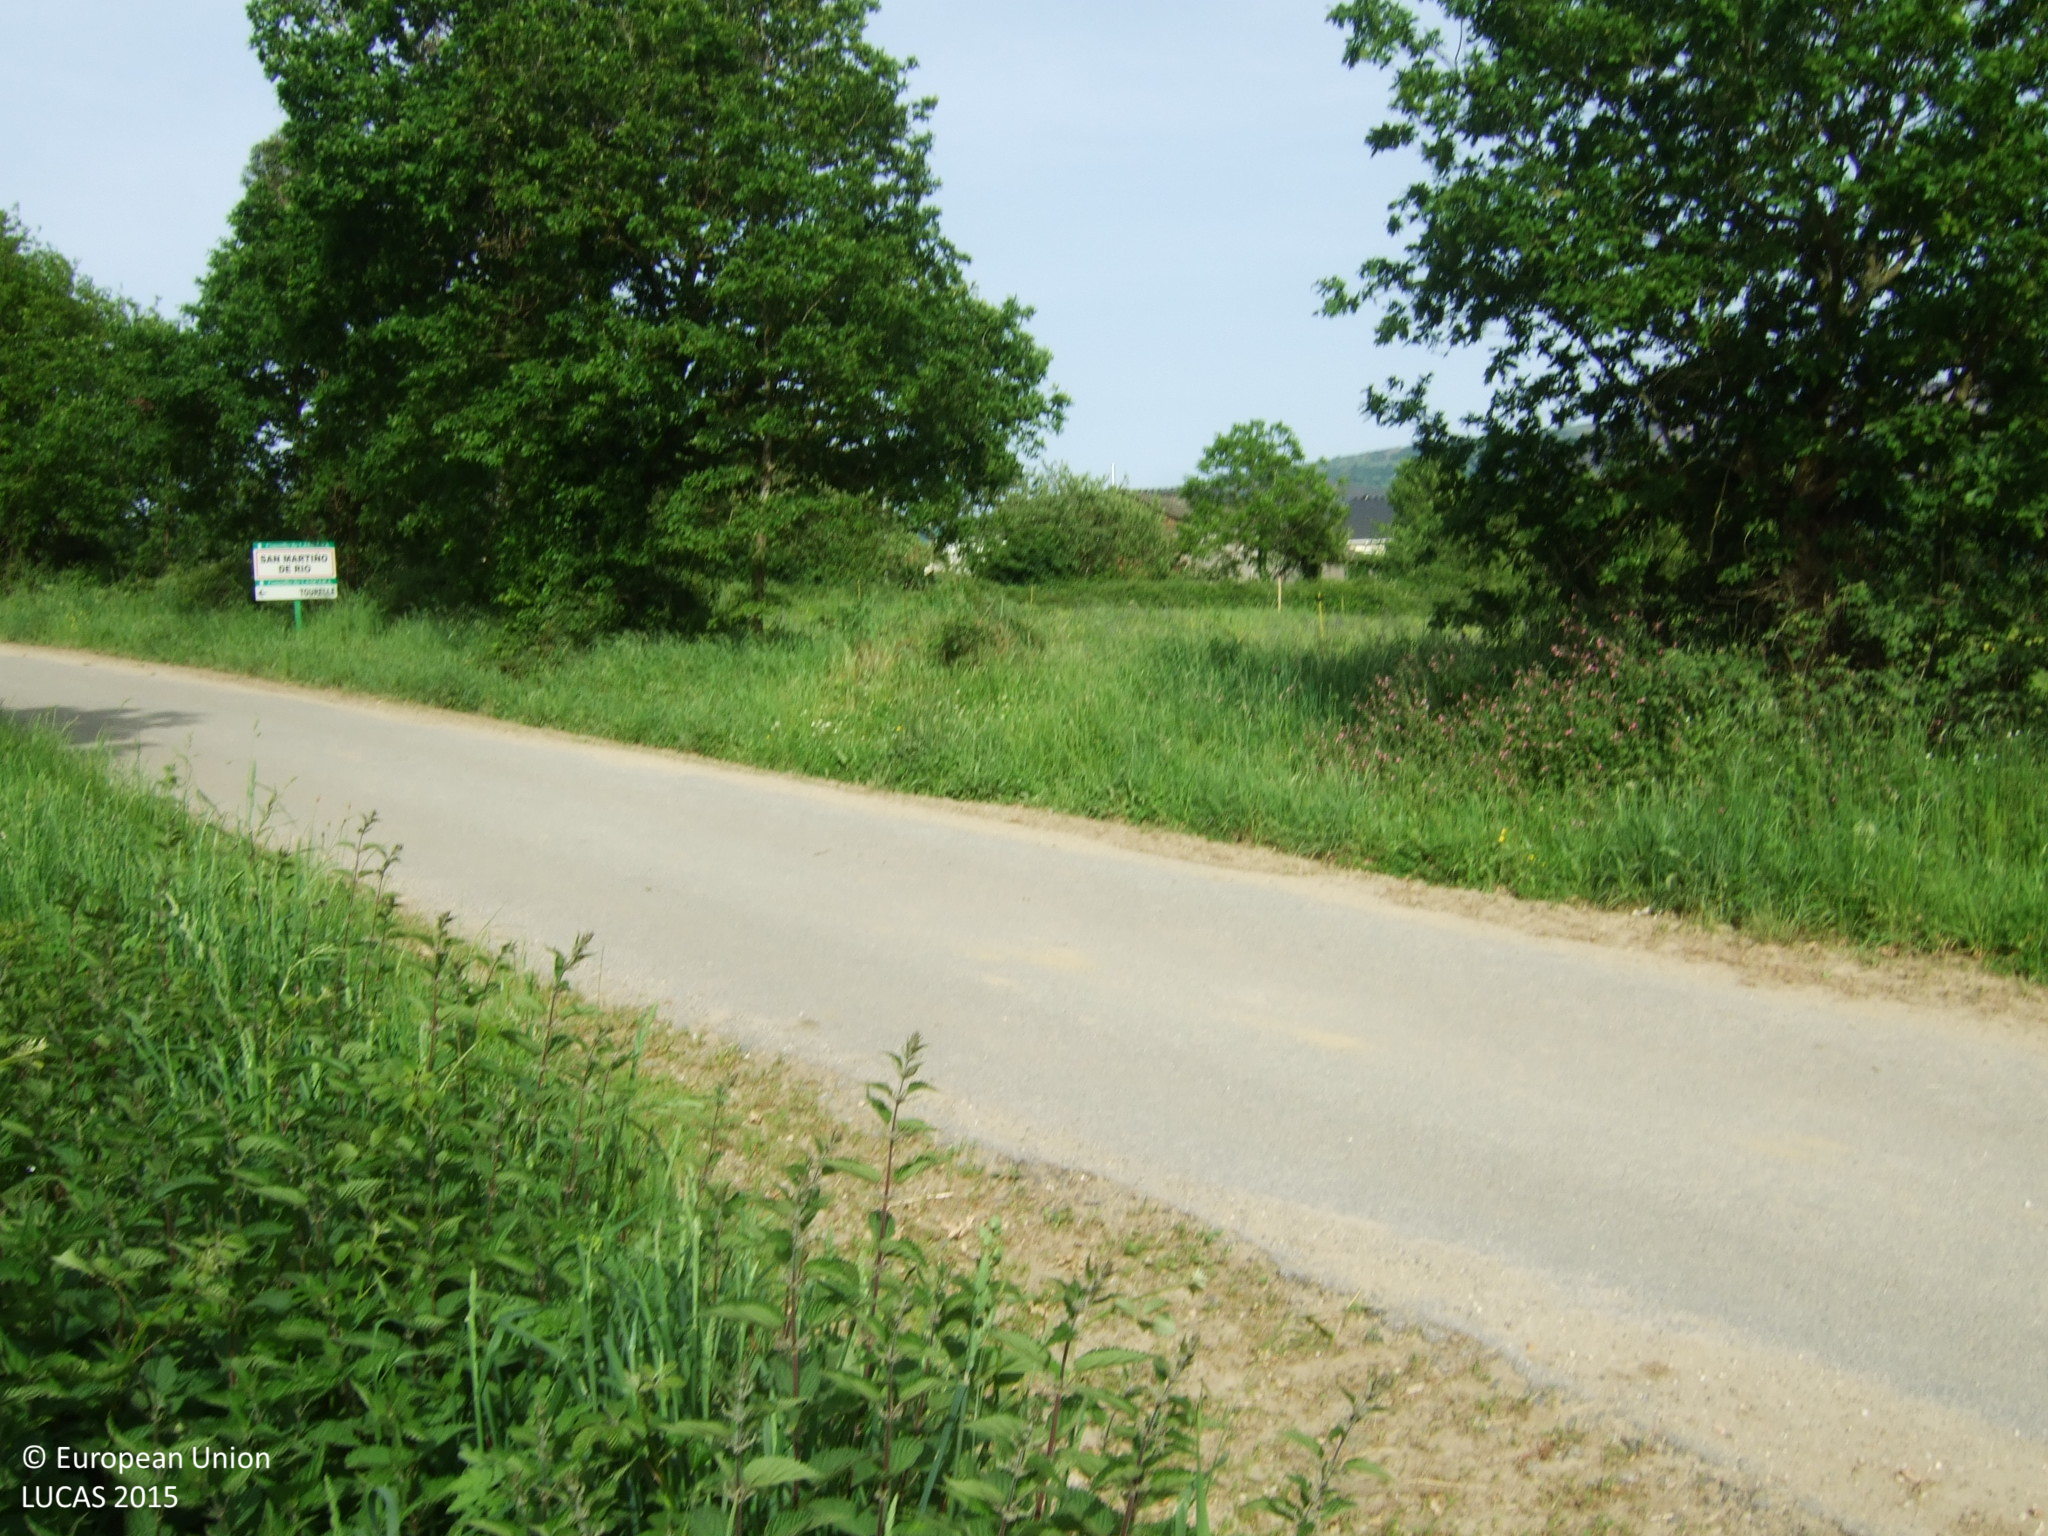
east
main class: Shrubland
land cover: Shrubland with sparse tree cover
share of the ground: > 75 %
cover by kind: shrubs 95 %, broadleaved forest trees 5 %
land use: Abandoned areas
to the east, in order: Shrubland with sparse tree cover; Paved roads, cycling and walking lanes; Abandoned hedges; Grassland without tree/shrub cover; Fences; Paved roads, cycling and walking lanes; Apple fruit; Artificial constructions in urban areas; Potatoes; Electric lines; Grassland without tree/shrub cover
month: May
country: ES
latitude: 42.8063
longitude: -7.3225
